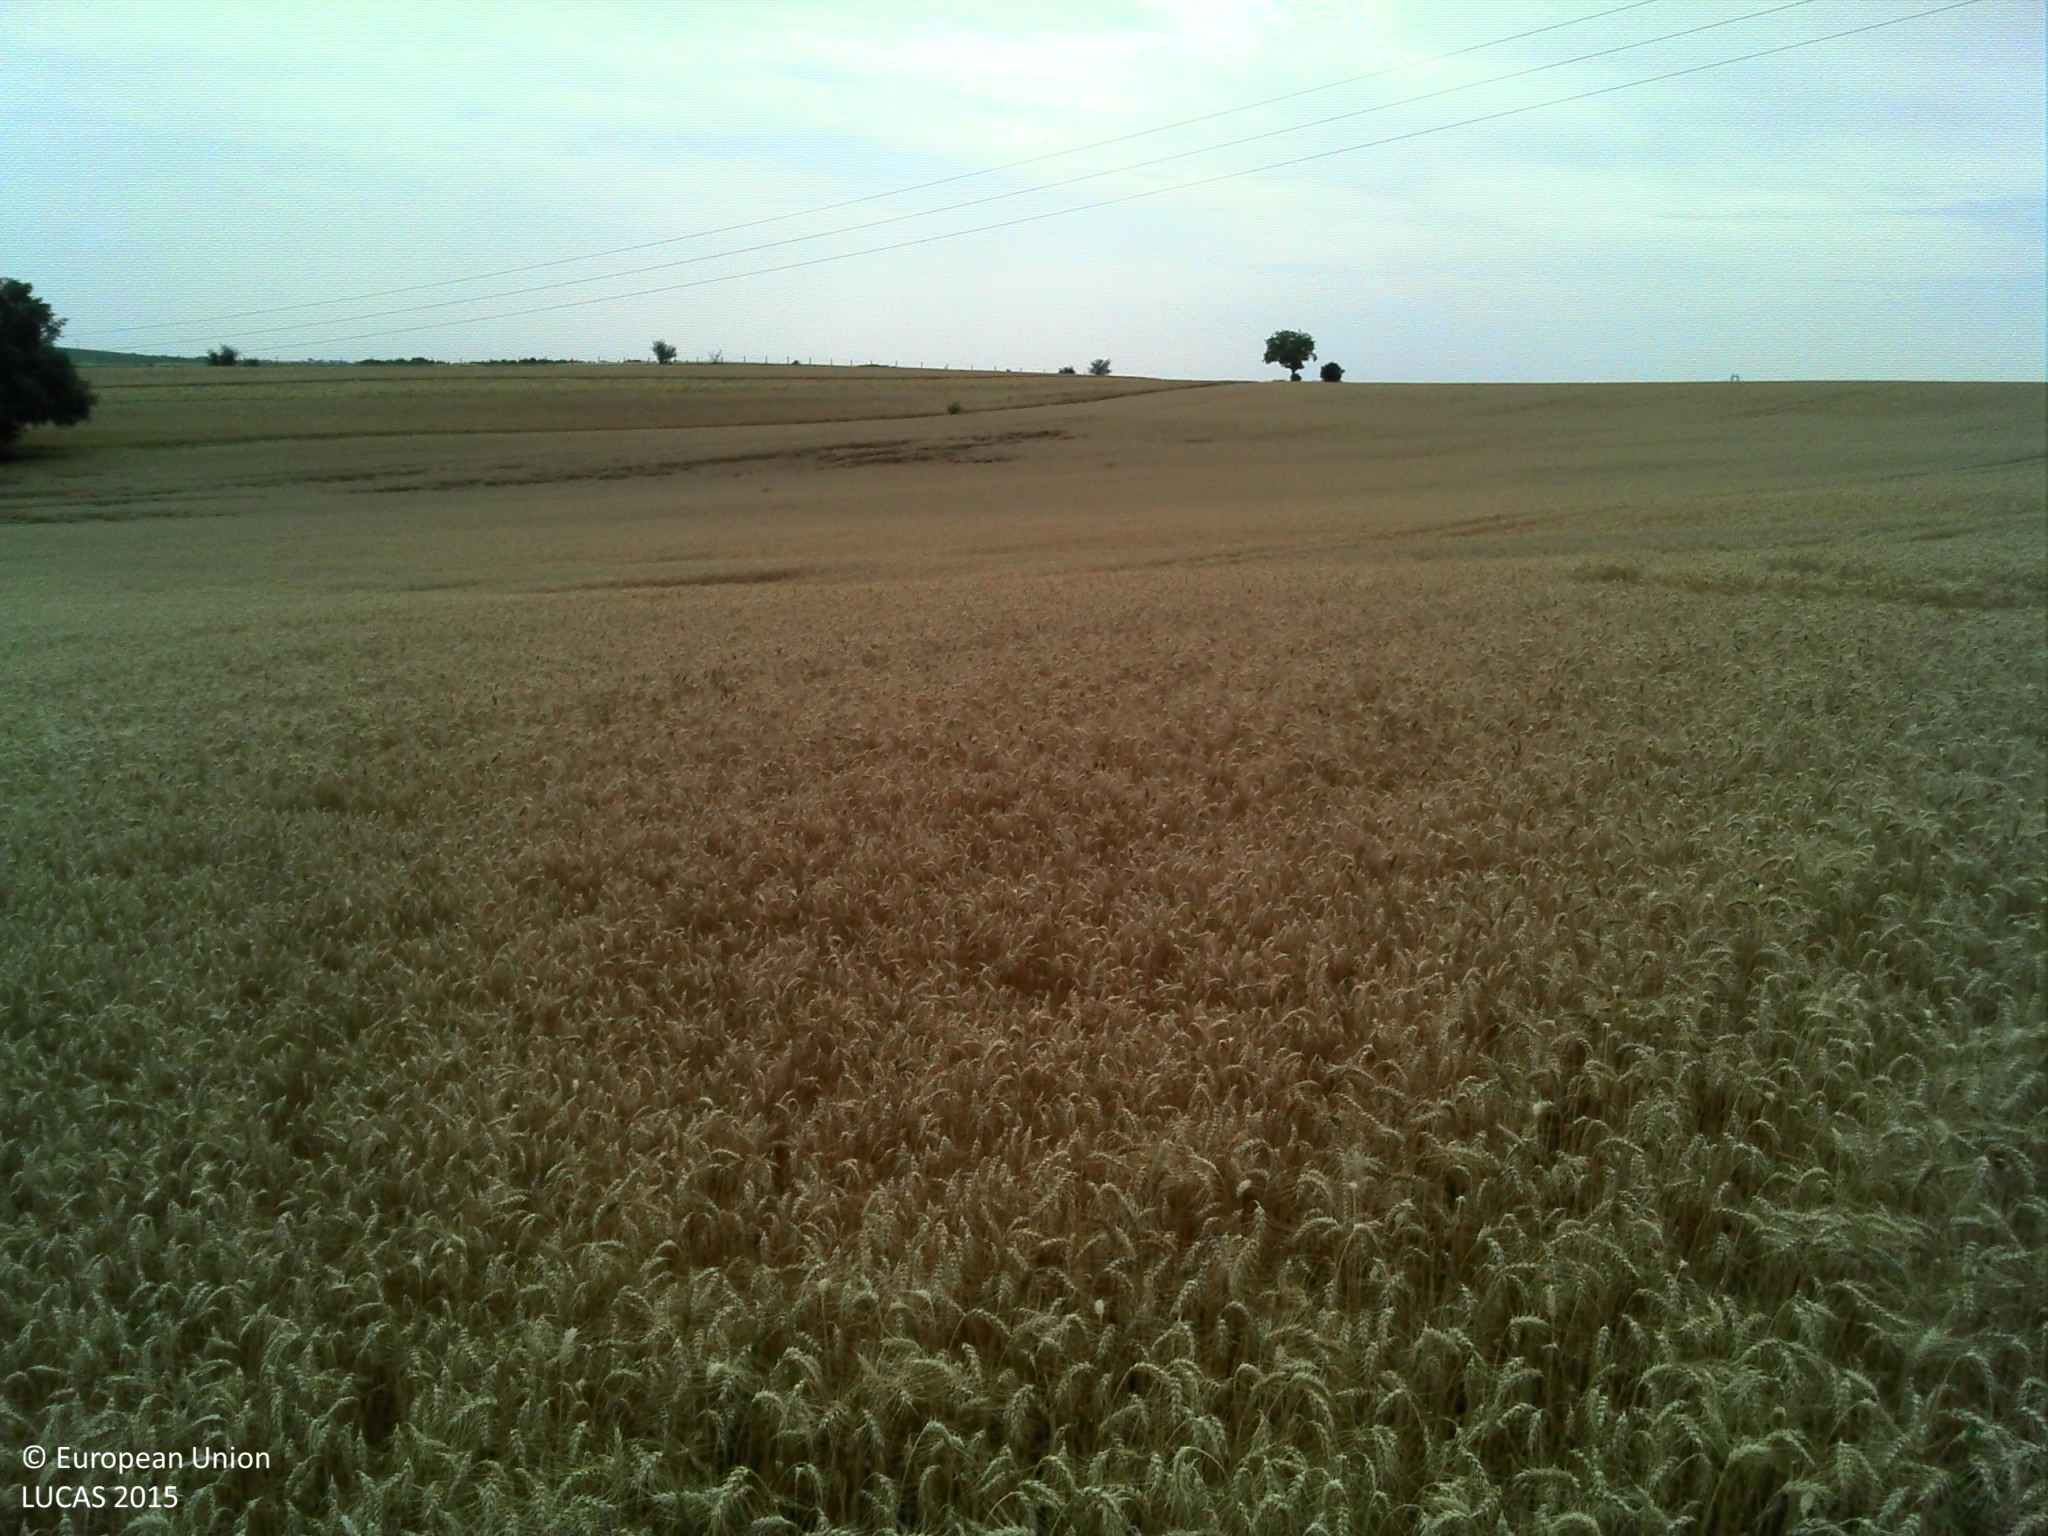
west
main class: Cropland
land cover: Durum wheat
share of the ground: > 75 %
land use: Agriculture (excluding fallow land and kitchen gardens)
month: July
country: FR
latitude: 43.5977
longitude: 1.0196
